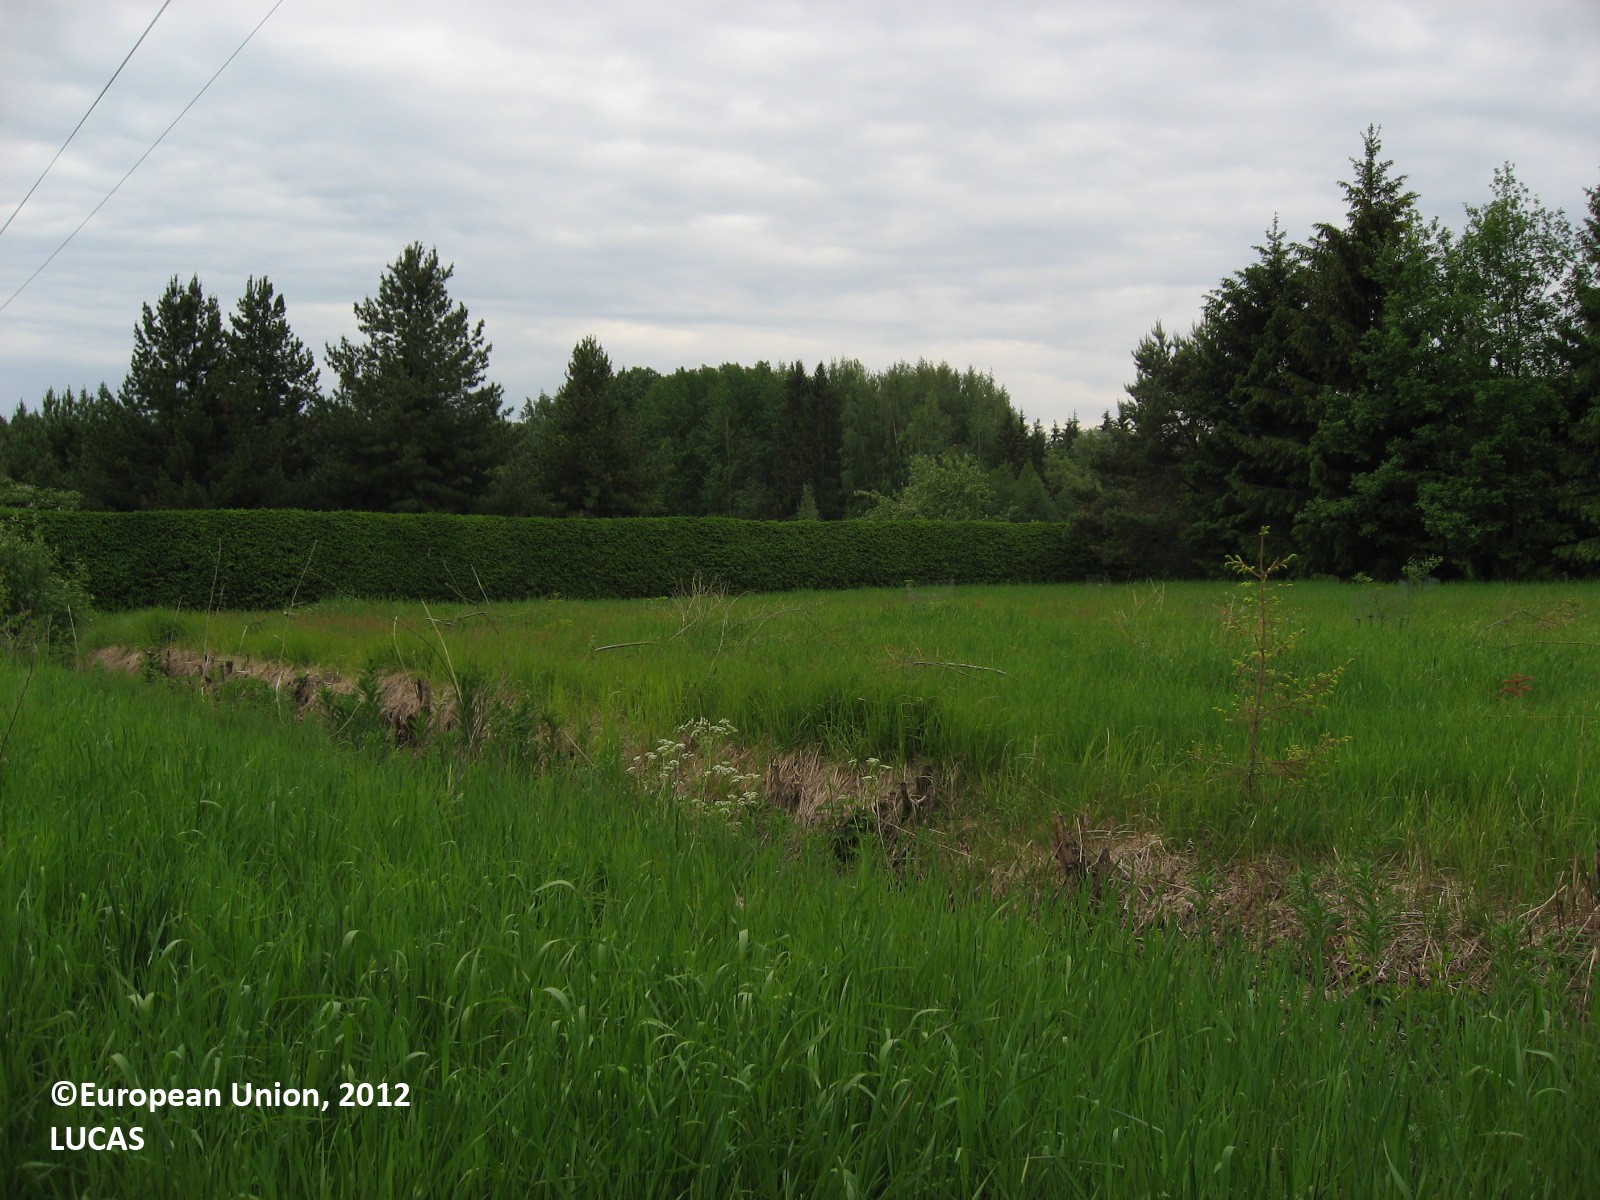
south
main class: Cropland
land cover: Other leguminous and mixtures for fodder
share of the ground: > 75 %
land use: Agriculture (excluding fallow land and kitchen gardens)
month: June
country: FI
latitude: 60.4065
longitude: 24.9481
